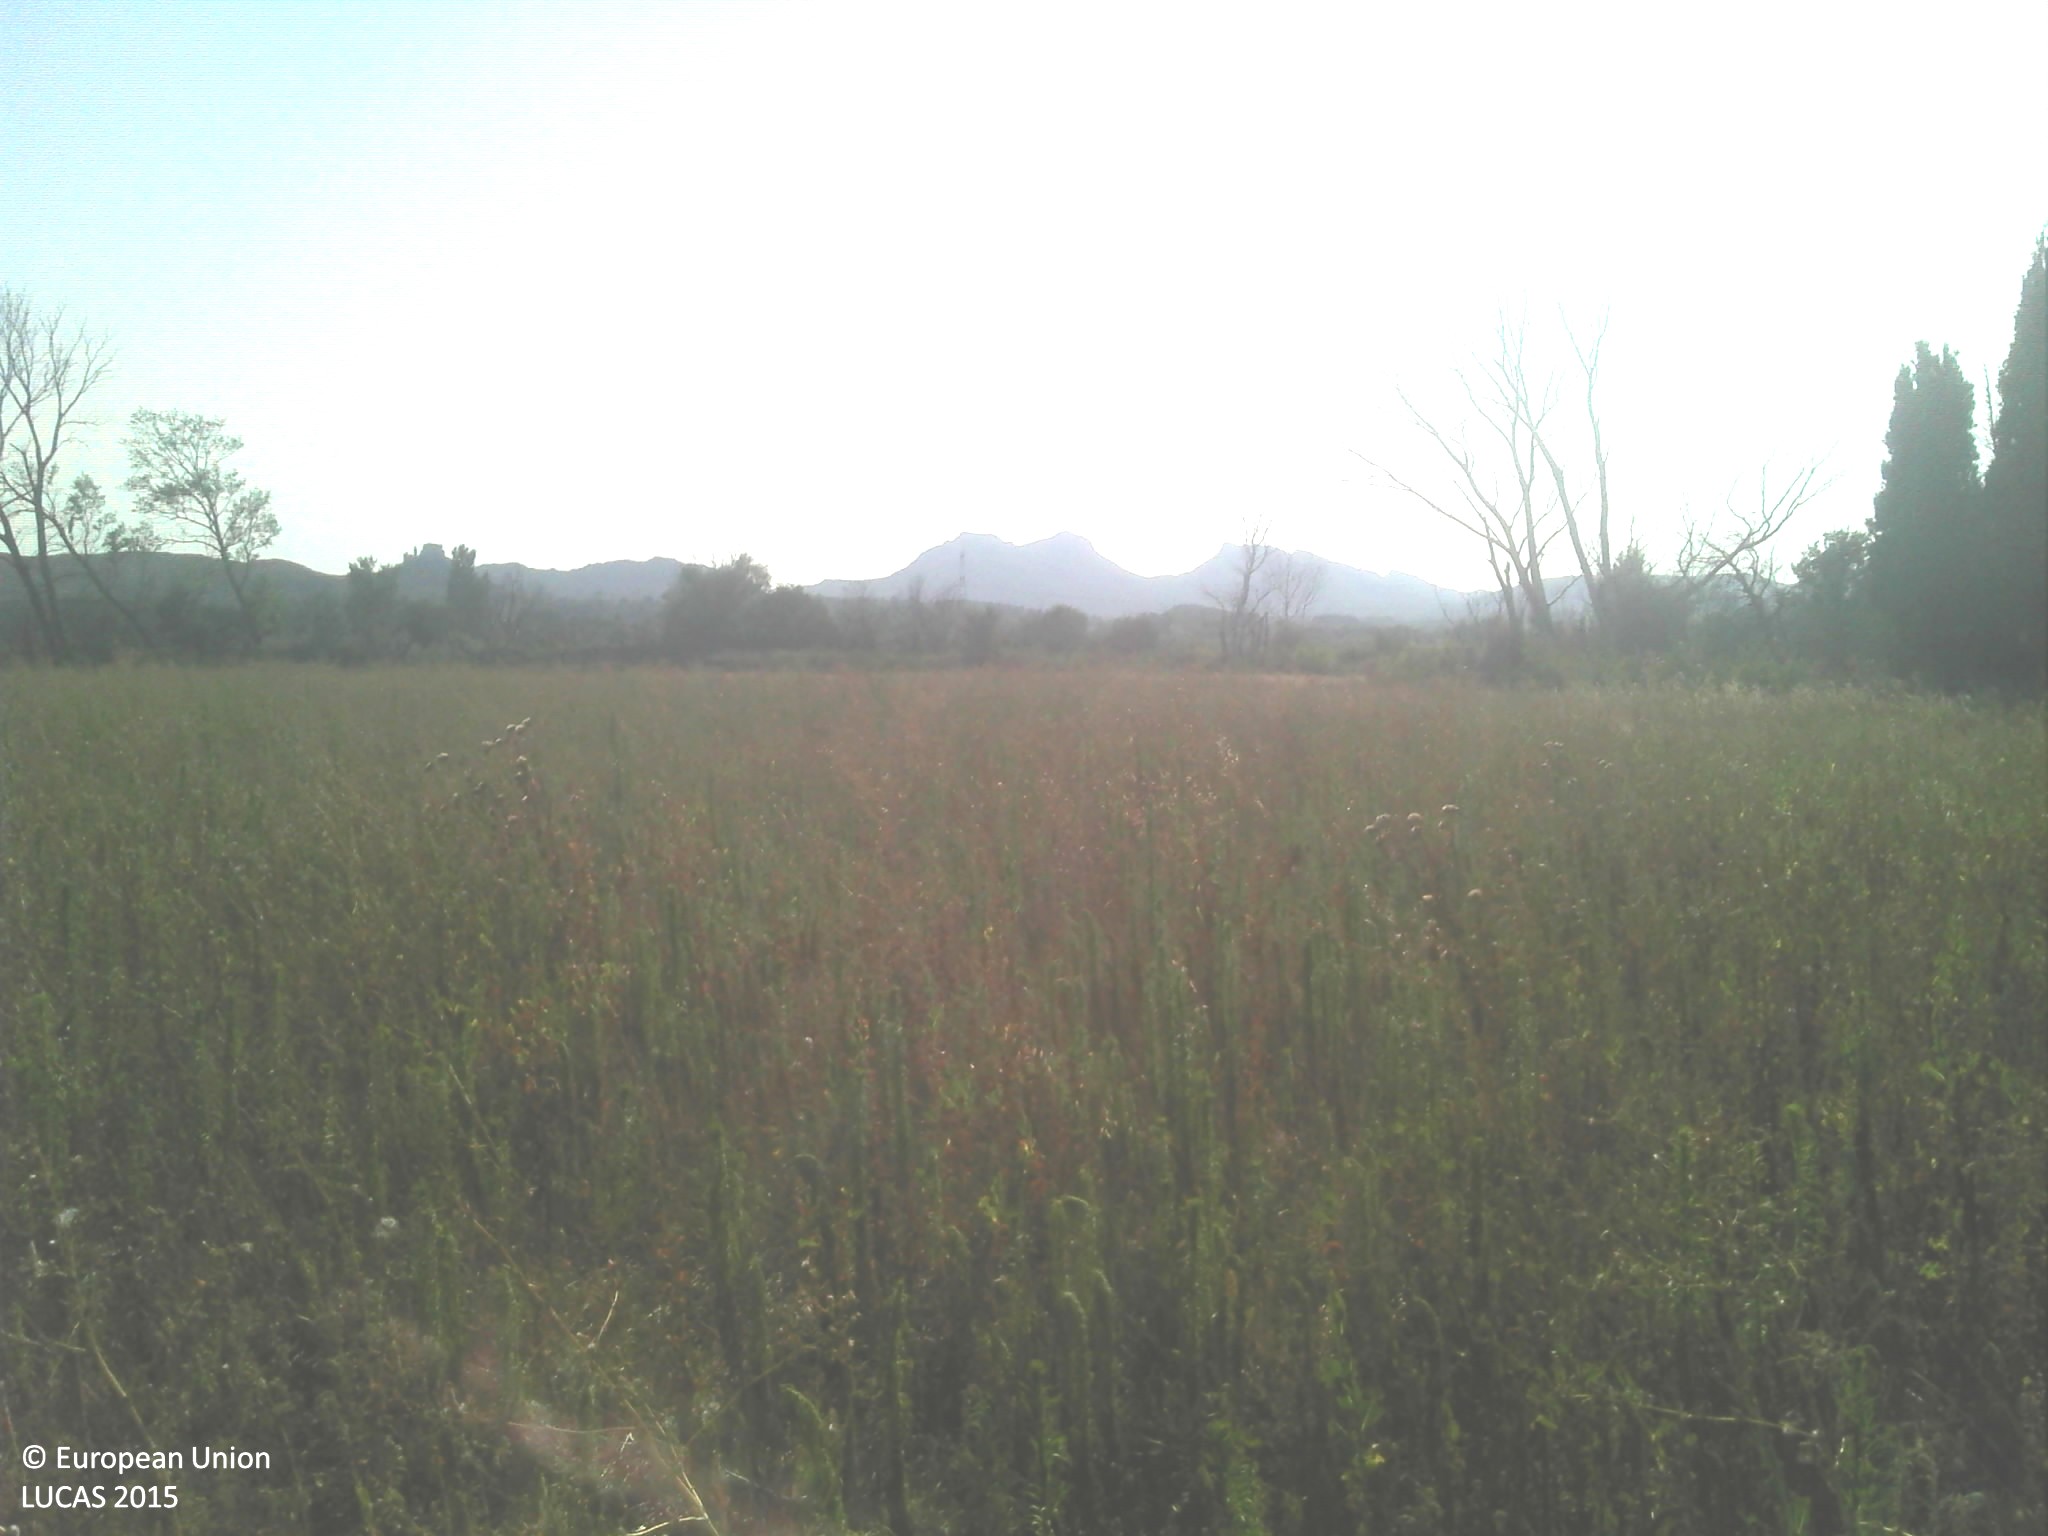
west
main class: Grassland
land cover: Spontaneously vegetated surfaces
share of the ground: > 75 %
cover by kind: herbaceous plants 100 %
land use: Fallow land
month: July
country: FR
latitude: 43.7268
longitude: 5.0560
